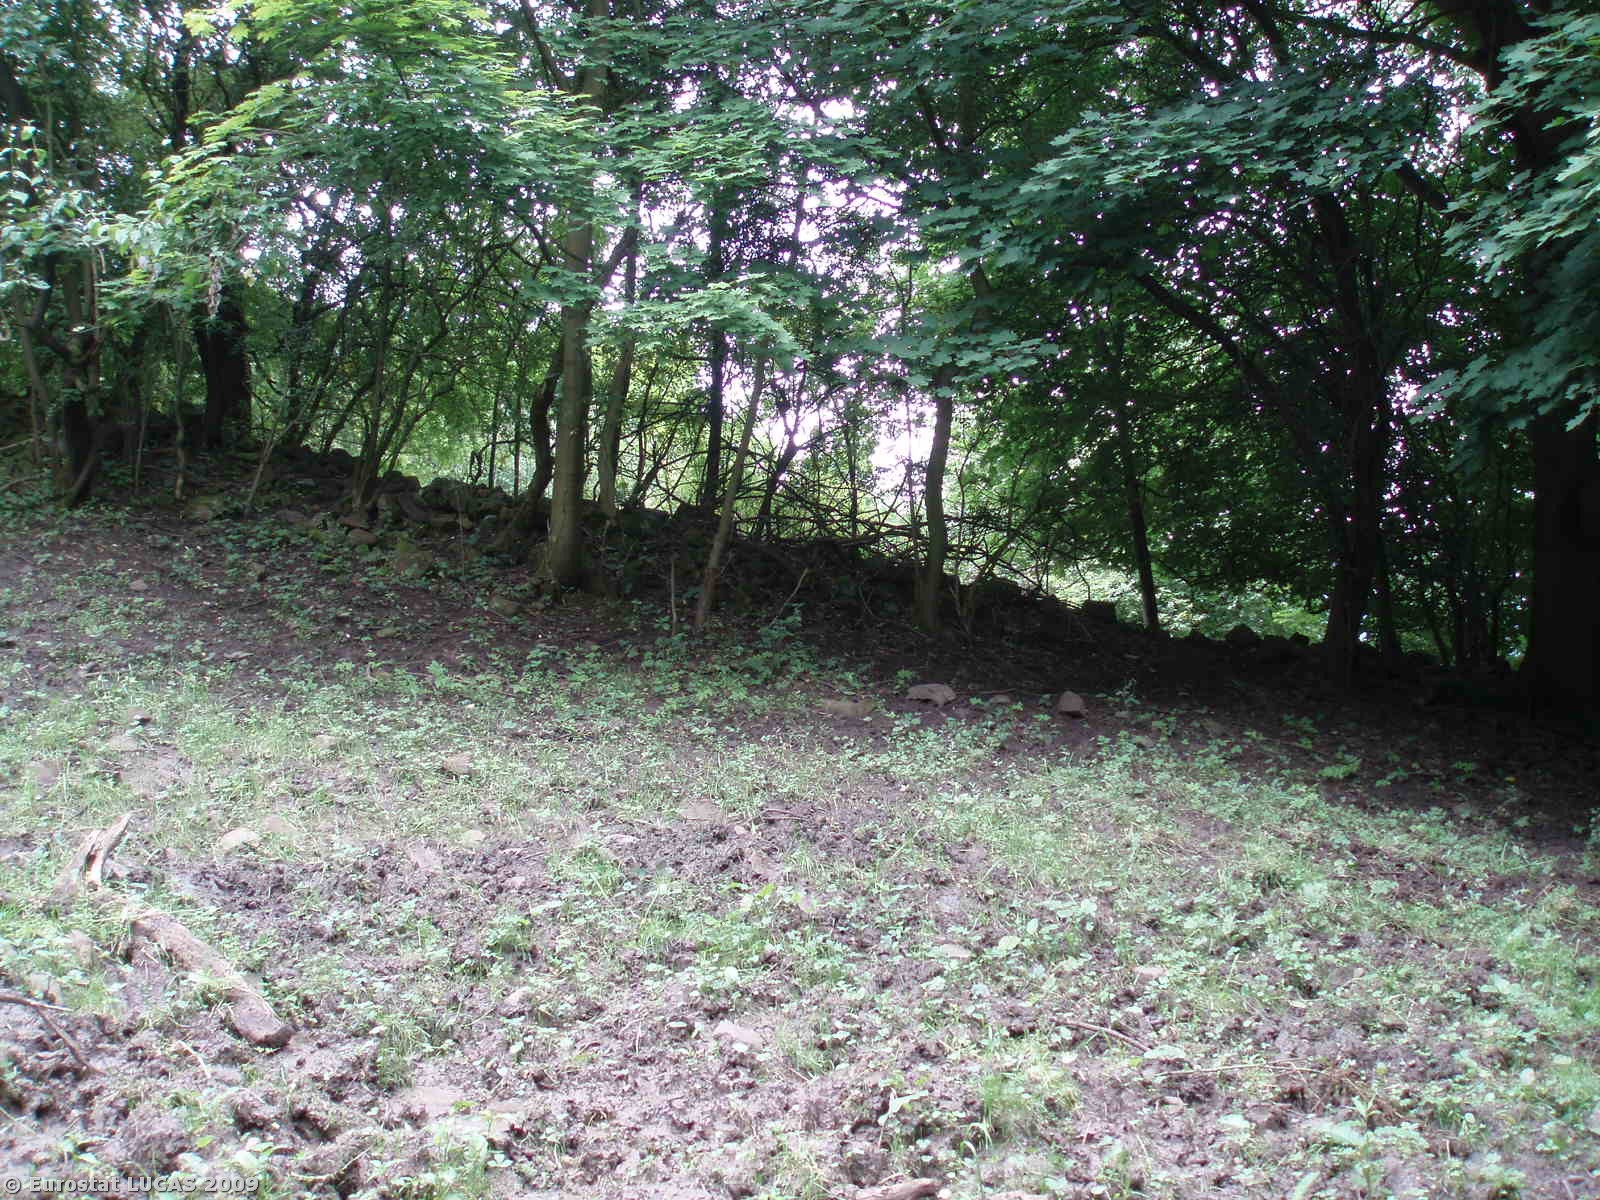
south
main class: Woodland
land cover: Broadleaved woodland
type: mesophytic deciduous forest
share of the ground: > 75 %
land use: Forestry
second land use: Nature reserves
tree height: > 5 m
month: July
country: CZ
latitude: 50.7009
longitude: 14.2064
